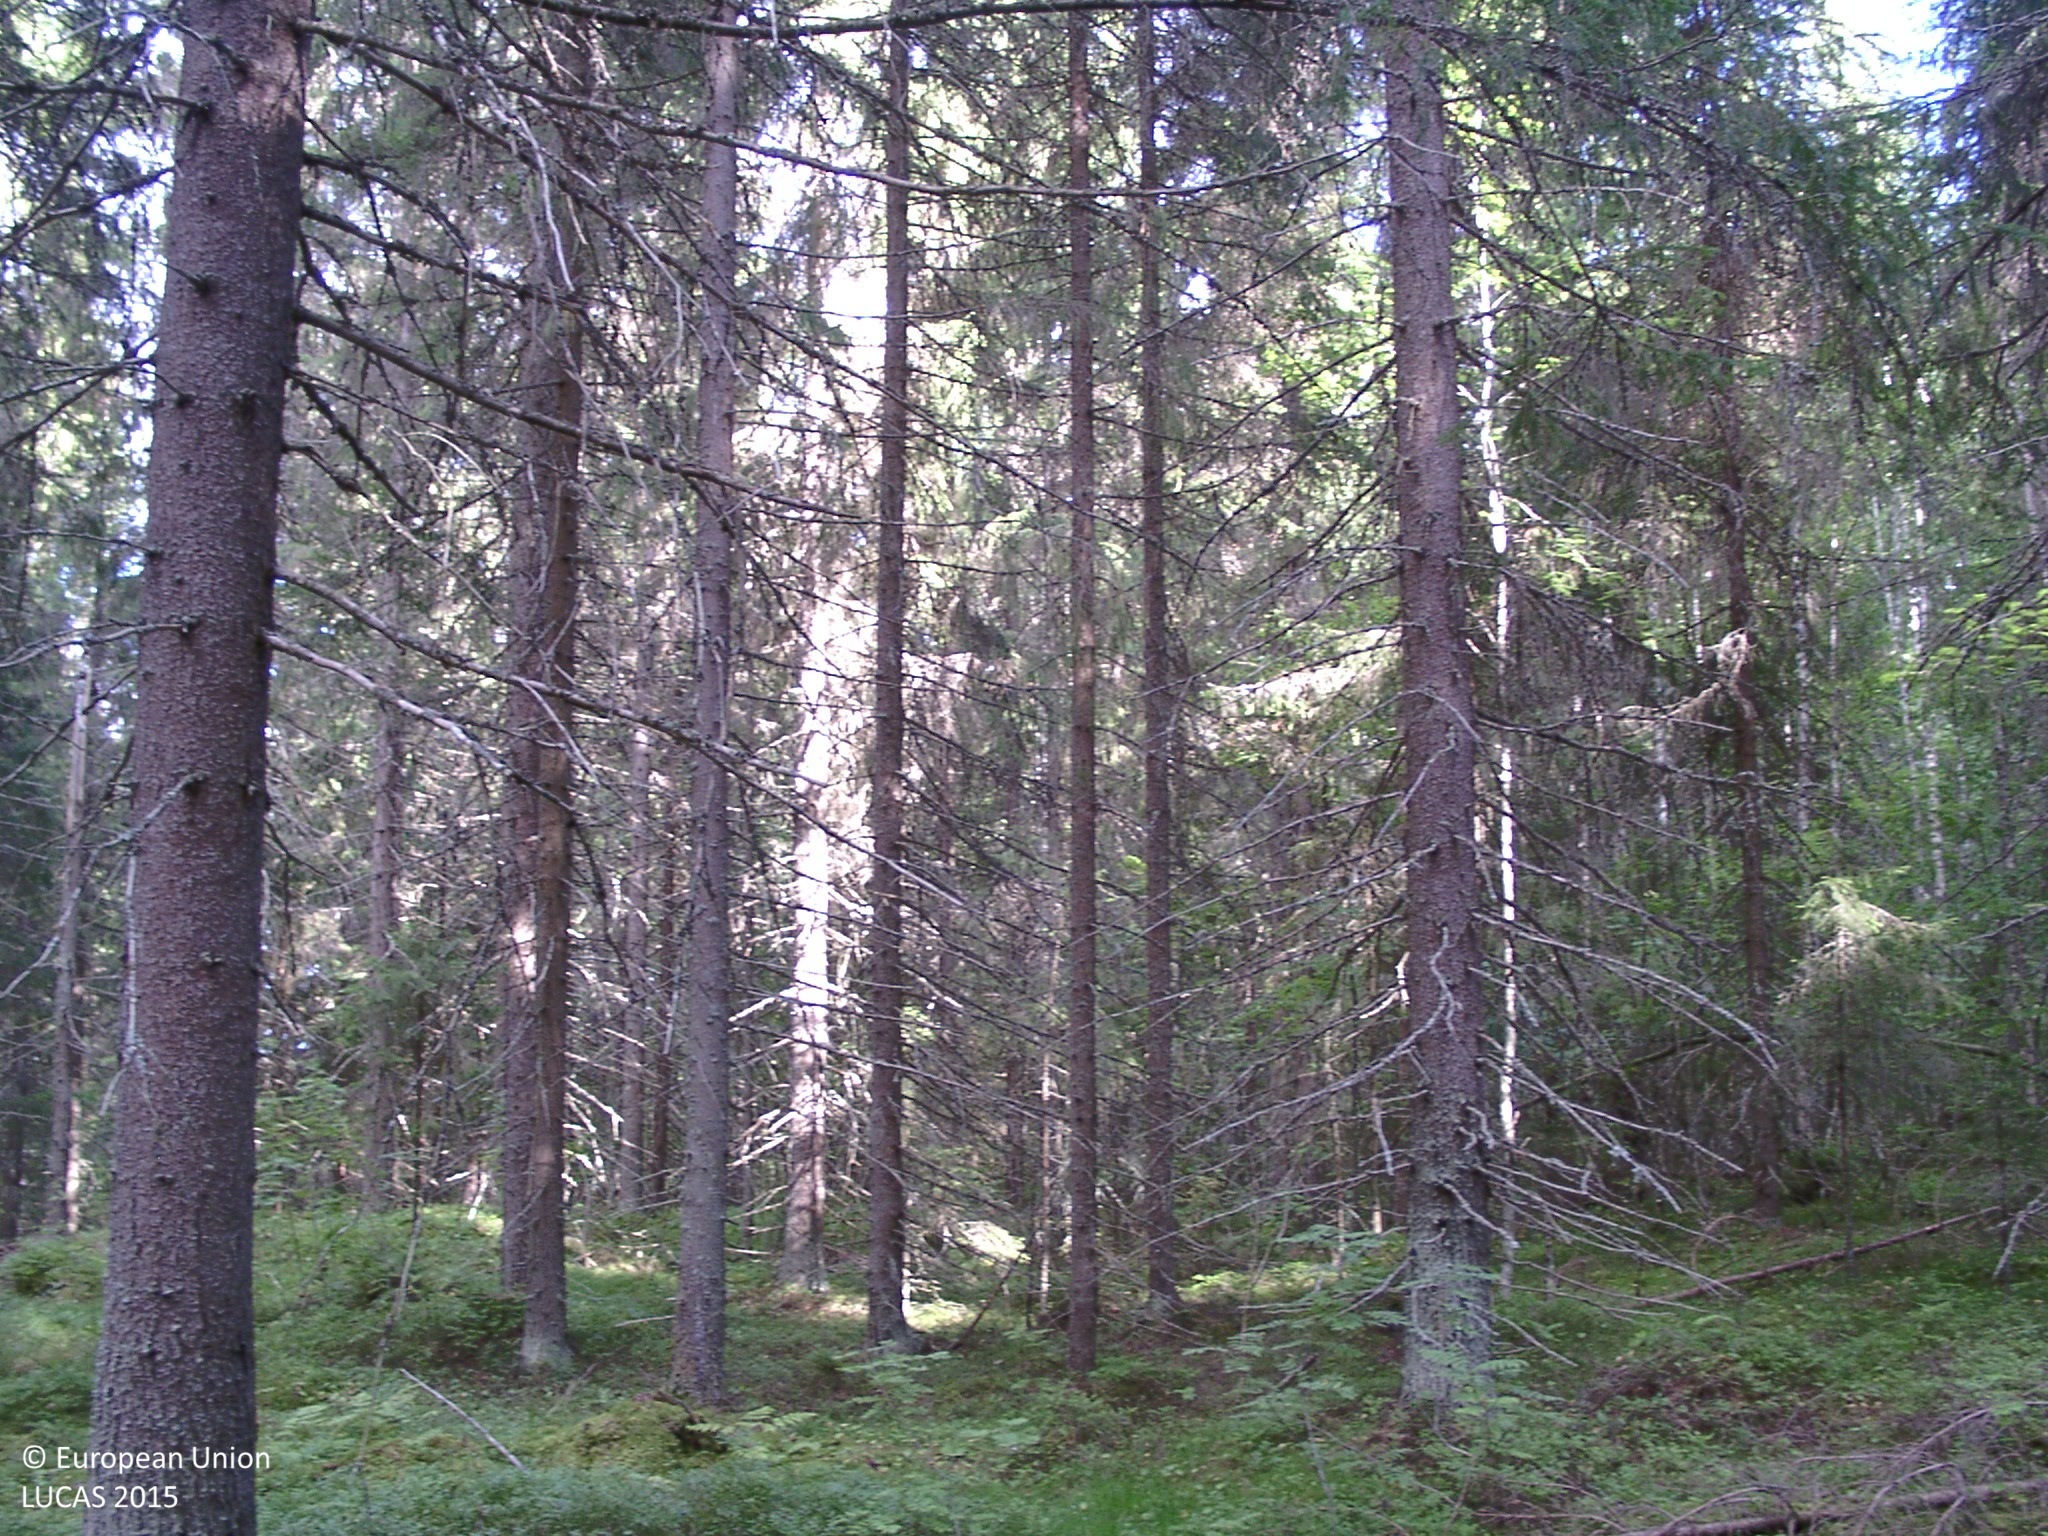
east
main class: Woodland
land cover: Spruce dominated coniferous woodland
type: boreal forest
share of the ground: > 75 %
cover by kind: coniferous forest trees 75 %, shrubs 10 %, broadleaved forest trees 5 %, herbaceous plants 5 %, lichens and mosses 5 %
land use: Forestry
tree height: > 5 m
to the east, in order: Spruce dominated coniferous woodland; Spruce dominated mixed woodland; Grass margins; Spruce dominated mixed woodland; Rivers and streams; Spruce dominated mixed woodland; Broadleaved woodland
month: August
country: FI
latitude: 62.4071
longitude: 25.5374
